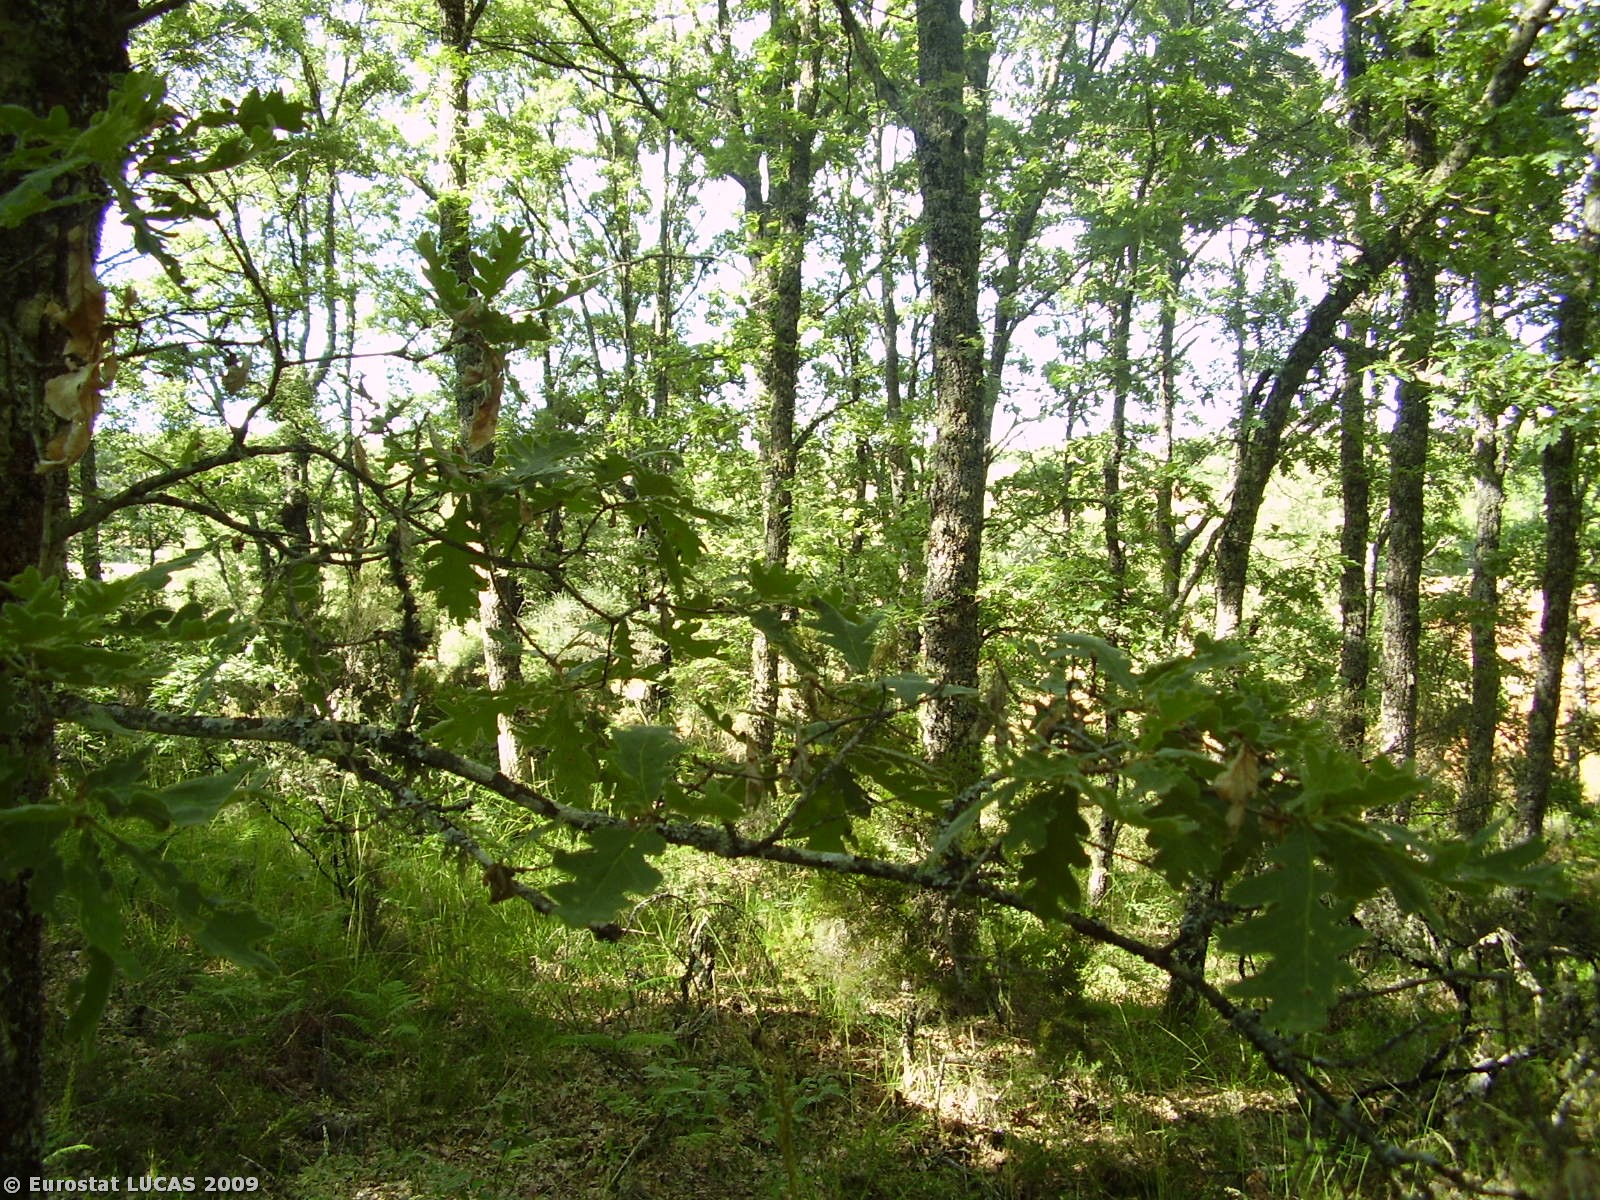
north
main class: Woodland
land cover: Broadleaved woodland
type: thermophilous deciduous forest
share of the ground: 50 - 75 %
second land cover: Spontaneously vegetated surfaces
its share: 25 - 50 %
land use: Forestry
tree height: > 5 m
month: June
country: PT
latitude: 41.8541
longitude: -6.9705
